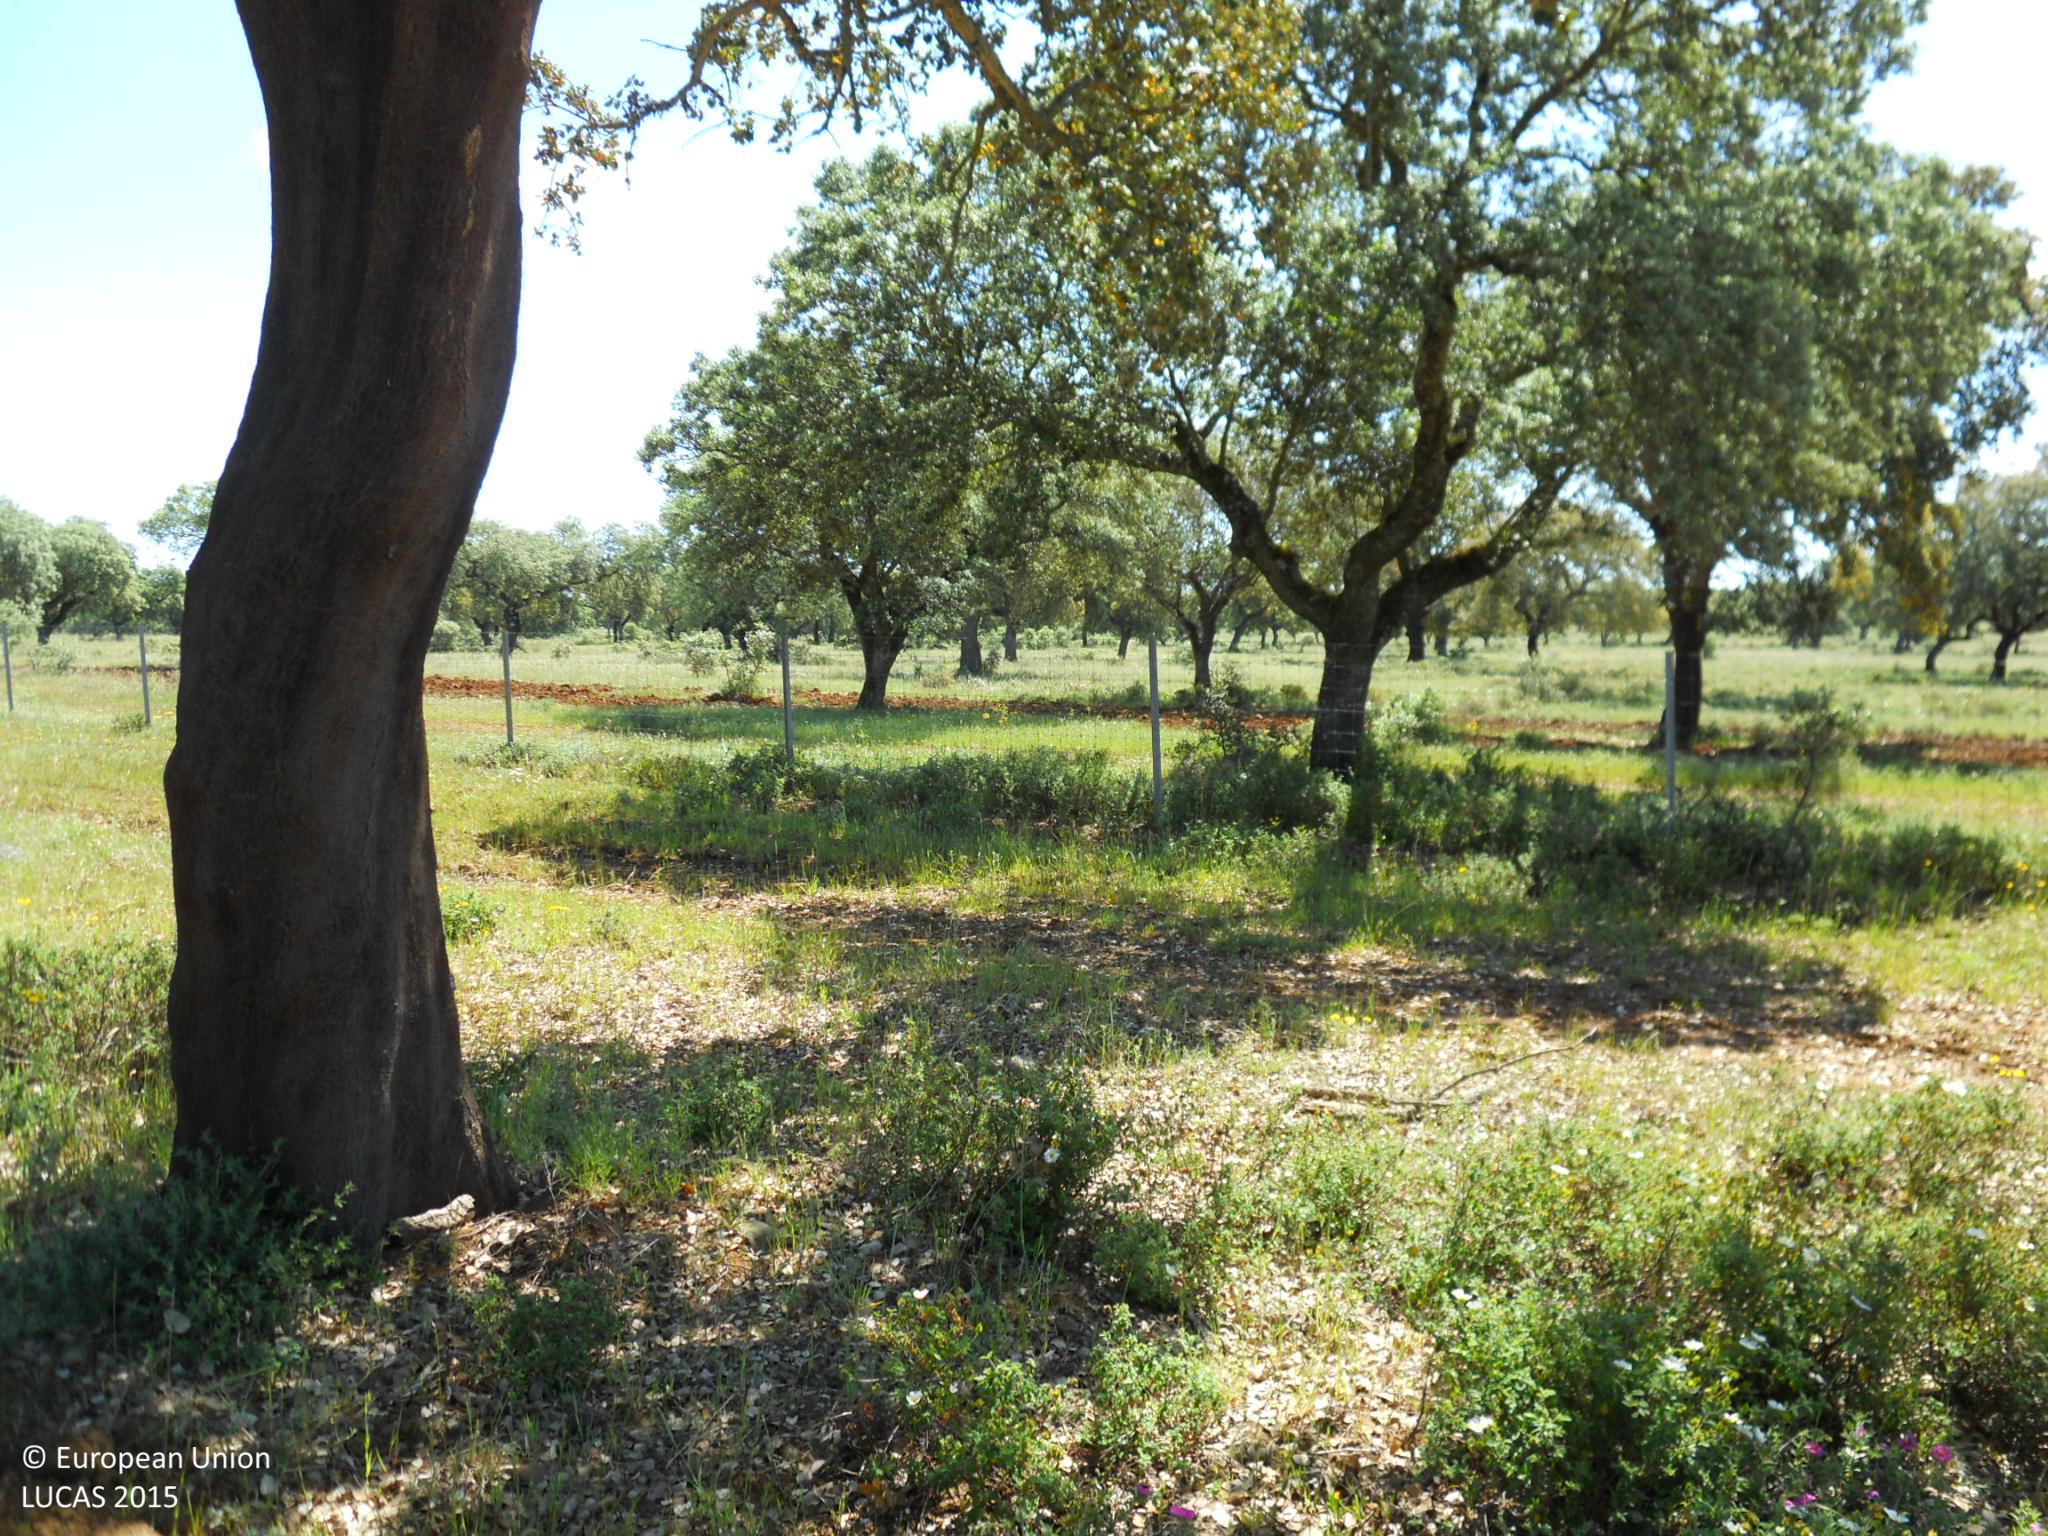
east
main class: Woodland
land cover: Broadleaved woodland
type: broadleaved evergreen forest
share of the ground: > 75 %
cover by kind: broadleaved forest trees 90 %, herbaceous plants 5 %, unconsolidated bare surface 5 %
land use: Forestry
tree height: > 5 m
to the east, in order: Broadleaved woodland; Tracks; Fences; Broadleaved woodland; Tracks; Broadleaved woodland; Other structural elements; Broadleaved woodland
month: April
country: ES
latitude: 39.1623
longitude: -6.7708
